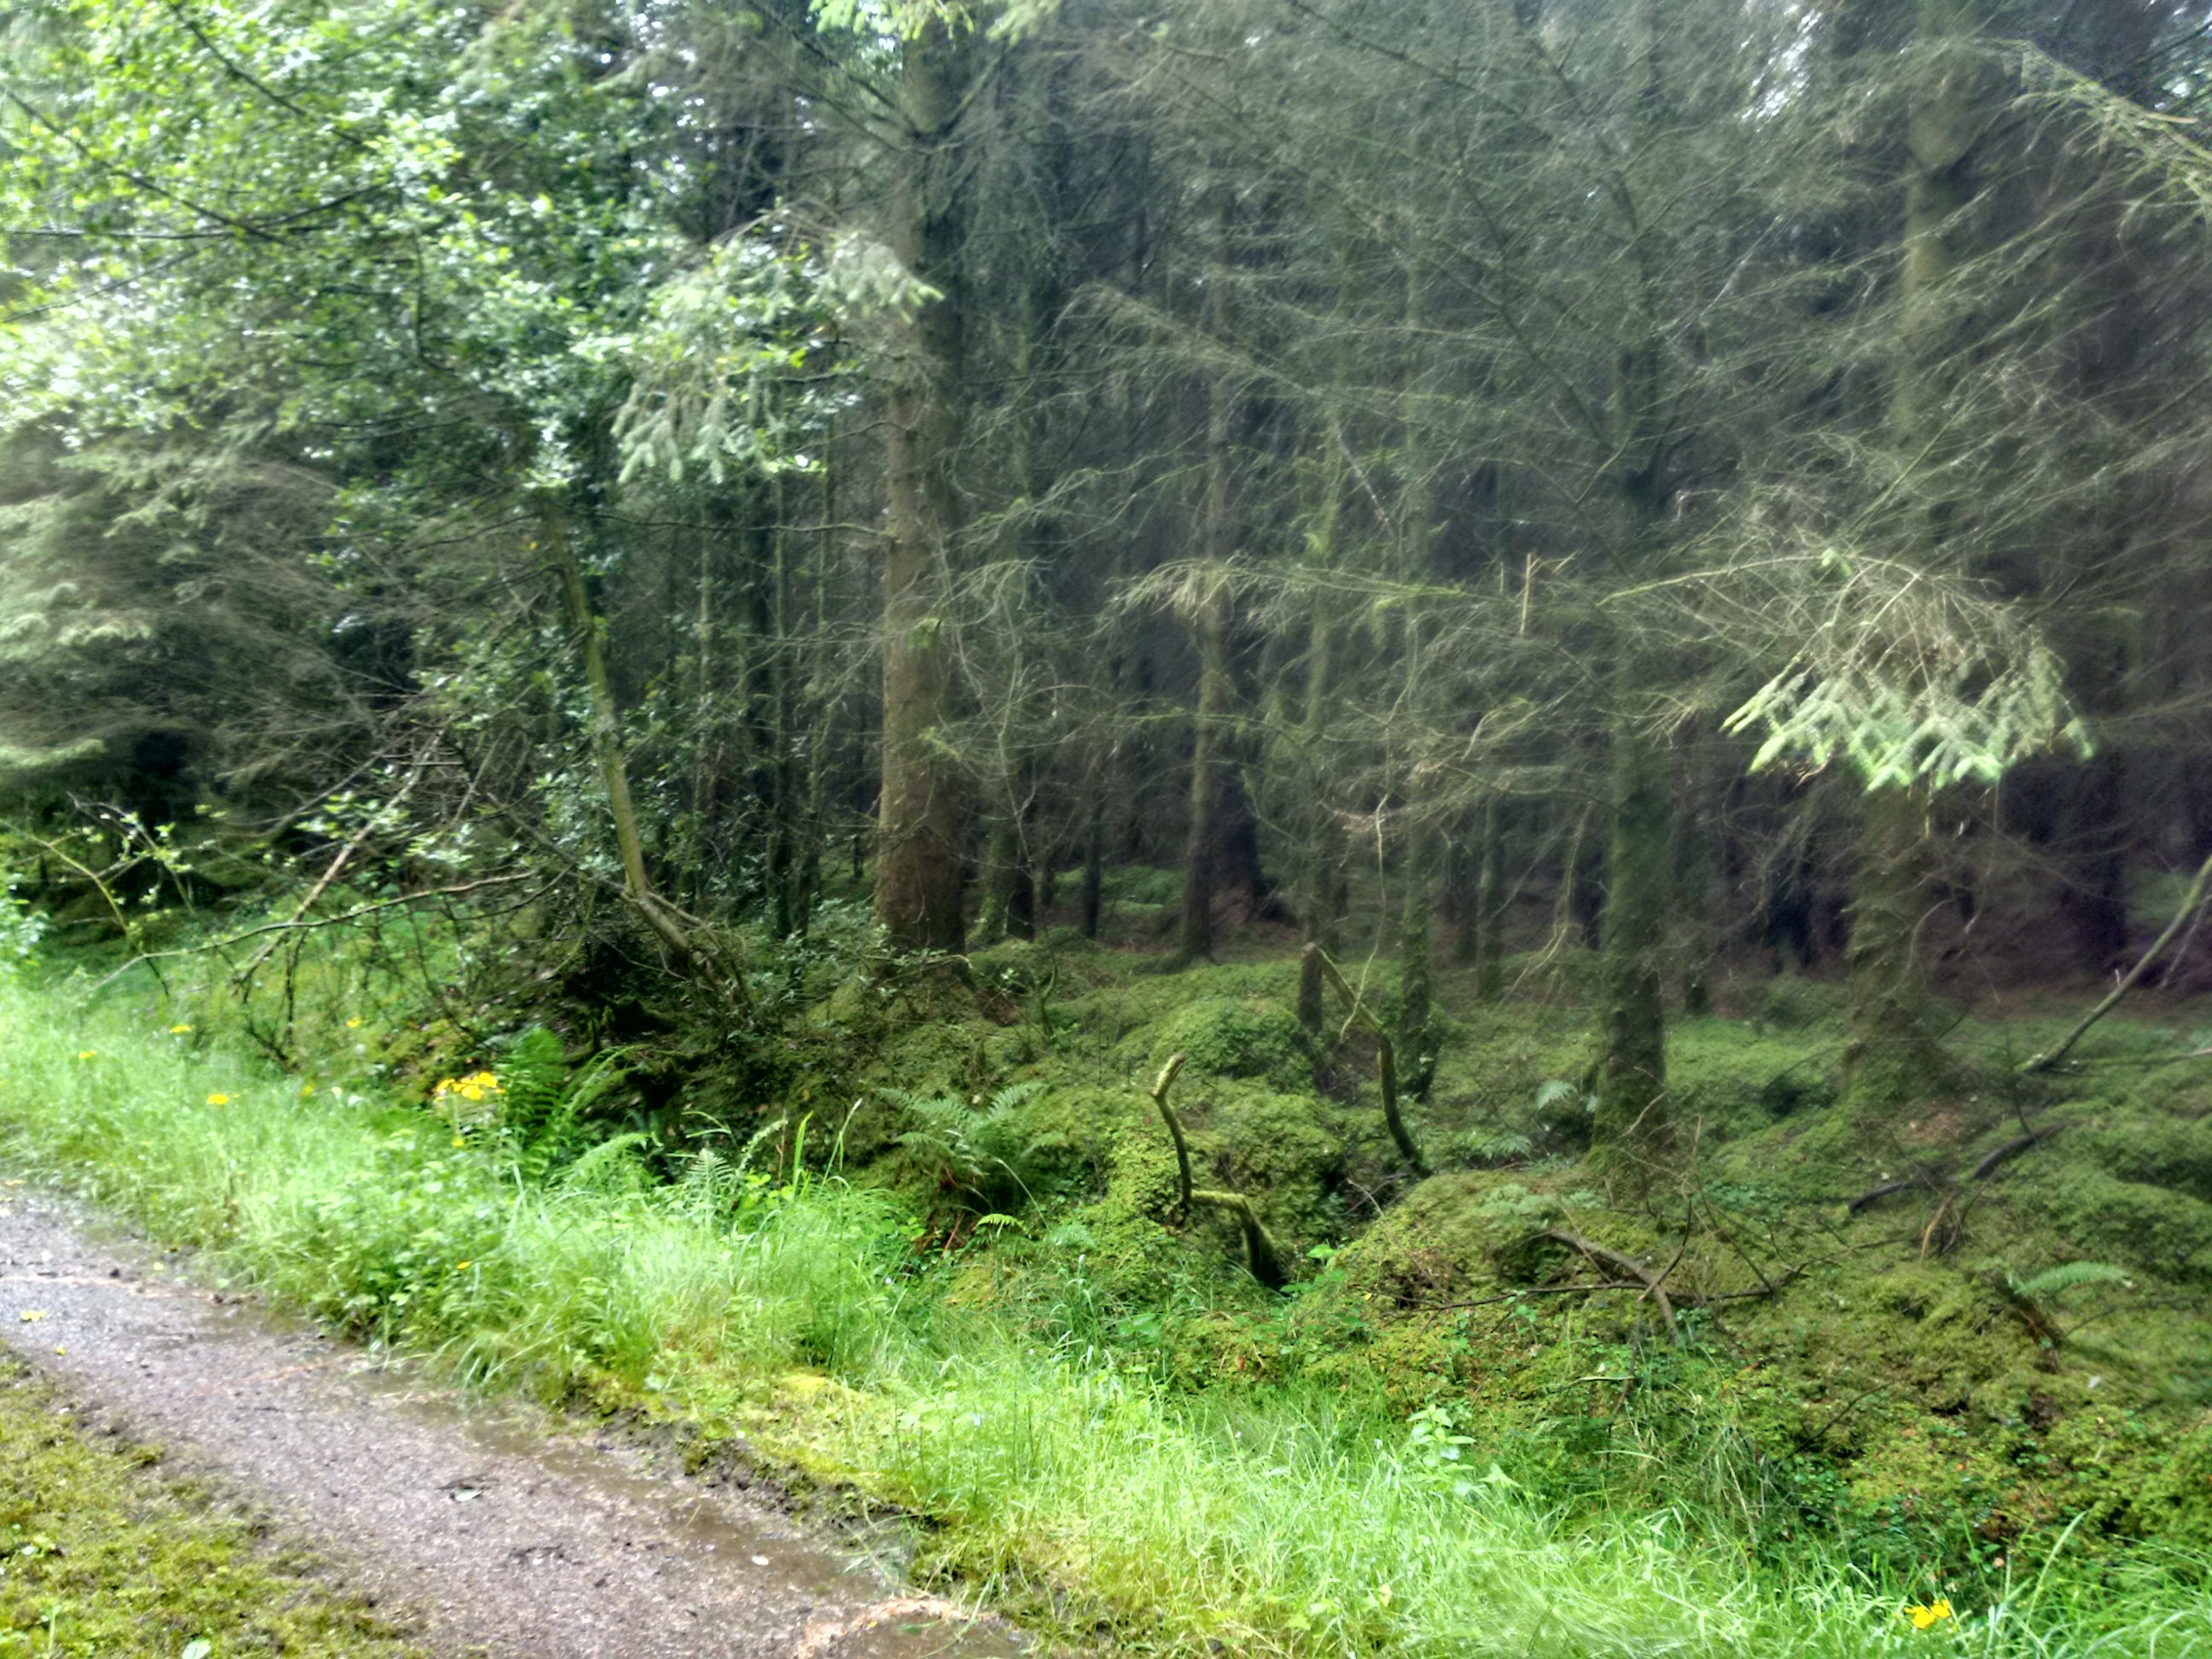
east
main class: Woodland
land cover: Spruce dominated coniferous woodland
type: exotic forest
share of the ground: > 75 %
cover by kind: coniferous forest trees 100 %
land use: Forestry
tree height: > 5 m
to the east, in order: Spruce dominated coniferous woodland; Ditches and canals; Grass margins; Tracks; Grass margins; Tracks; Grass margins; Ditches and canals; Spruce dominated coniferous woodland; Ditches and canals; Grass margins; Tracks; Grass margins; Tracks; Grass margins; Ditches and canals; Spruce dominated coniferous woodland
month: July
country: GB
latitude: 54.4040
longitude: -7.0725
